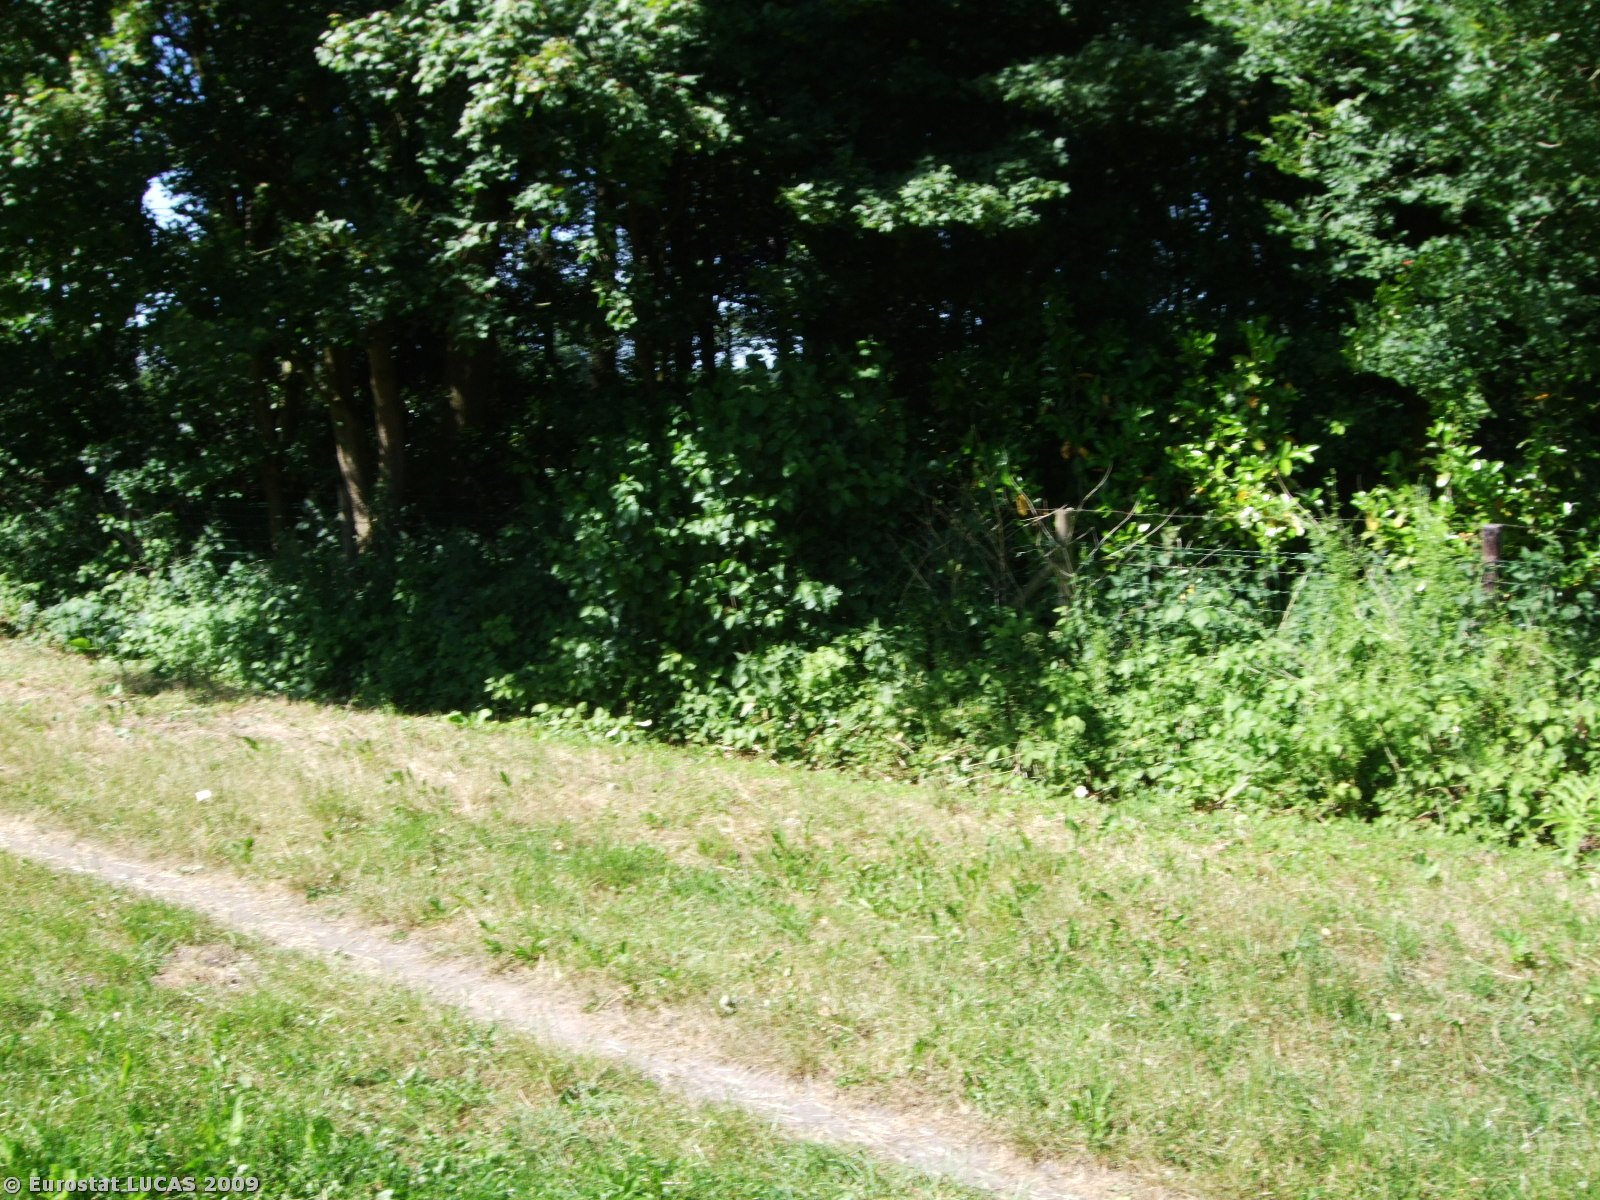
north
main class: Grassland
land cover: Grassland with sparse tree/shrub cover
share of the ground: > 75 %
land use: Road transport
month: June
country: NL
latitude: 51.5523
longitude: 5.4551
